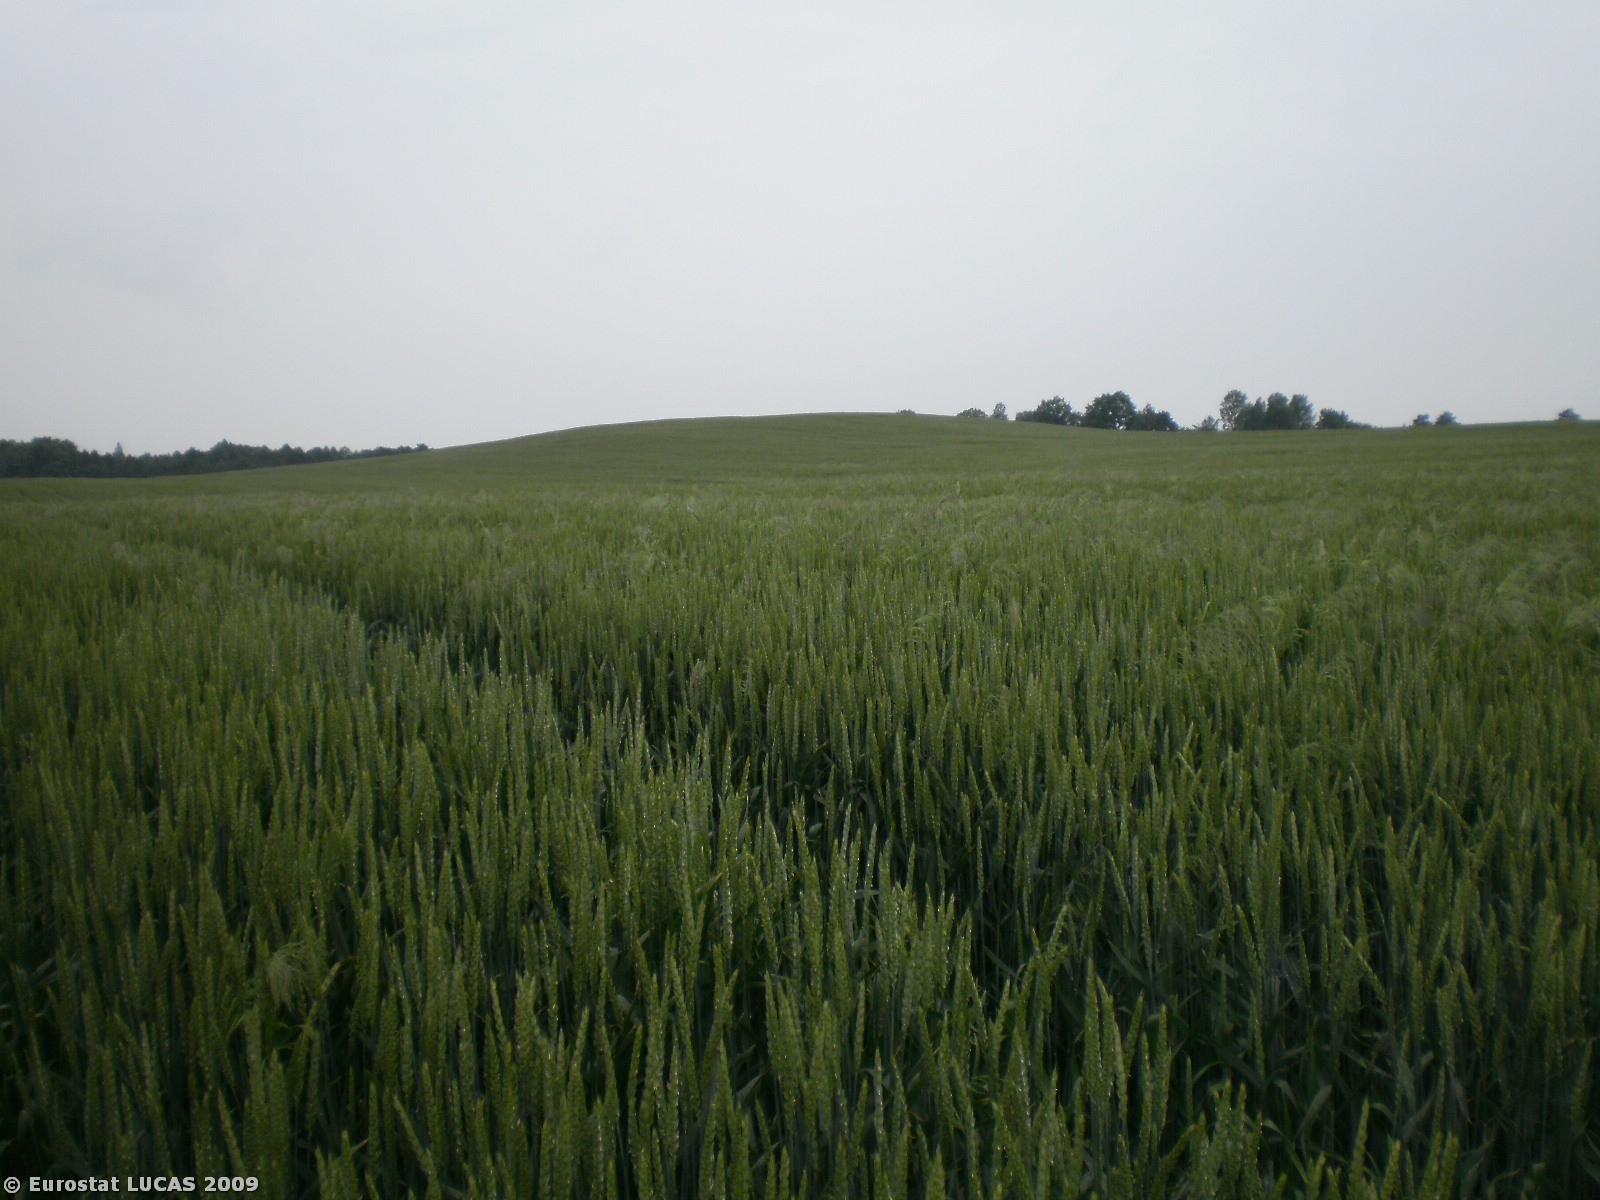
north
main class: Cropland
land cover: Common wheat
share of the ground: > 75 %
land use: Agriculture (excluding fallow land and kitchen gardens)
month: June
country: PL
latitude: 53.6290
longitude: 19.9048
